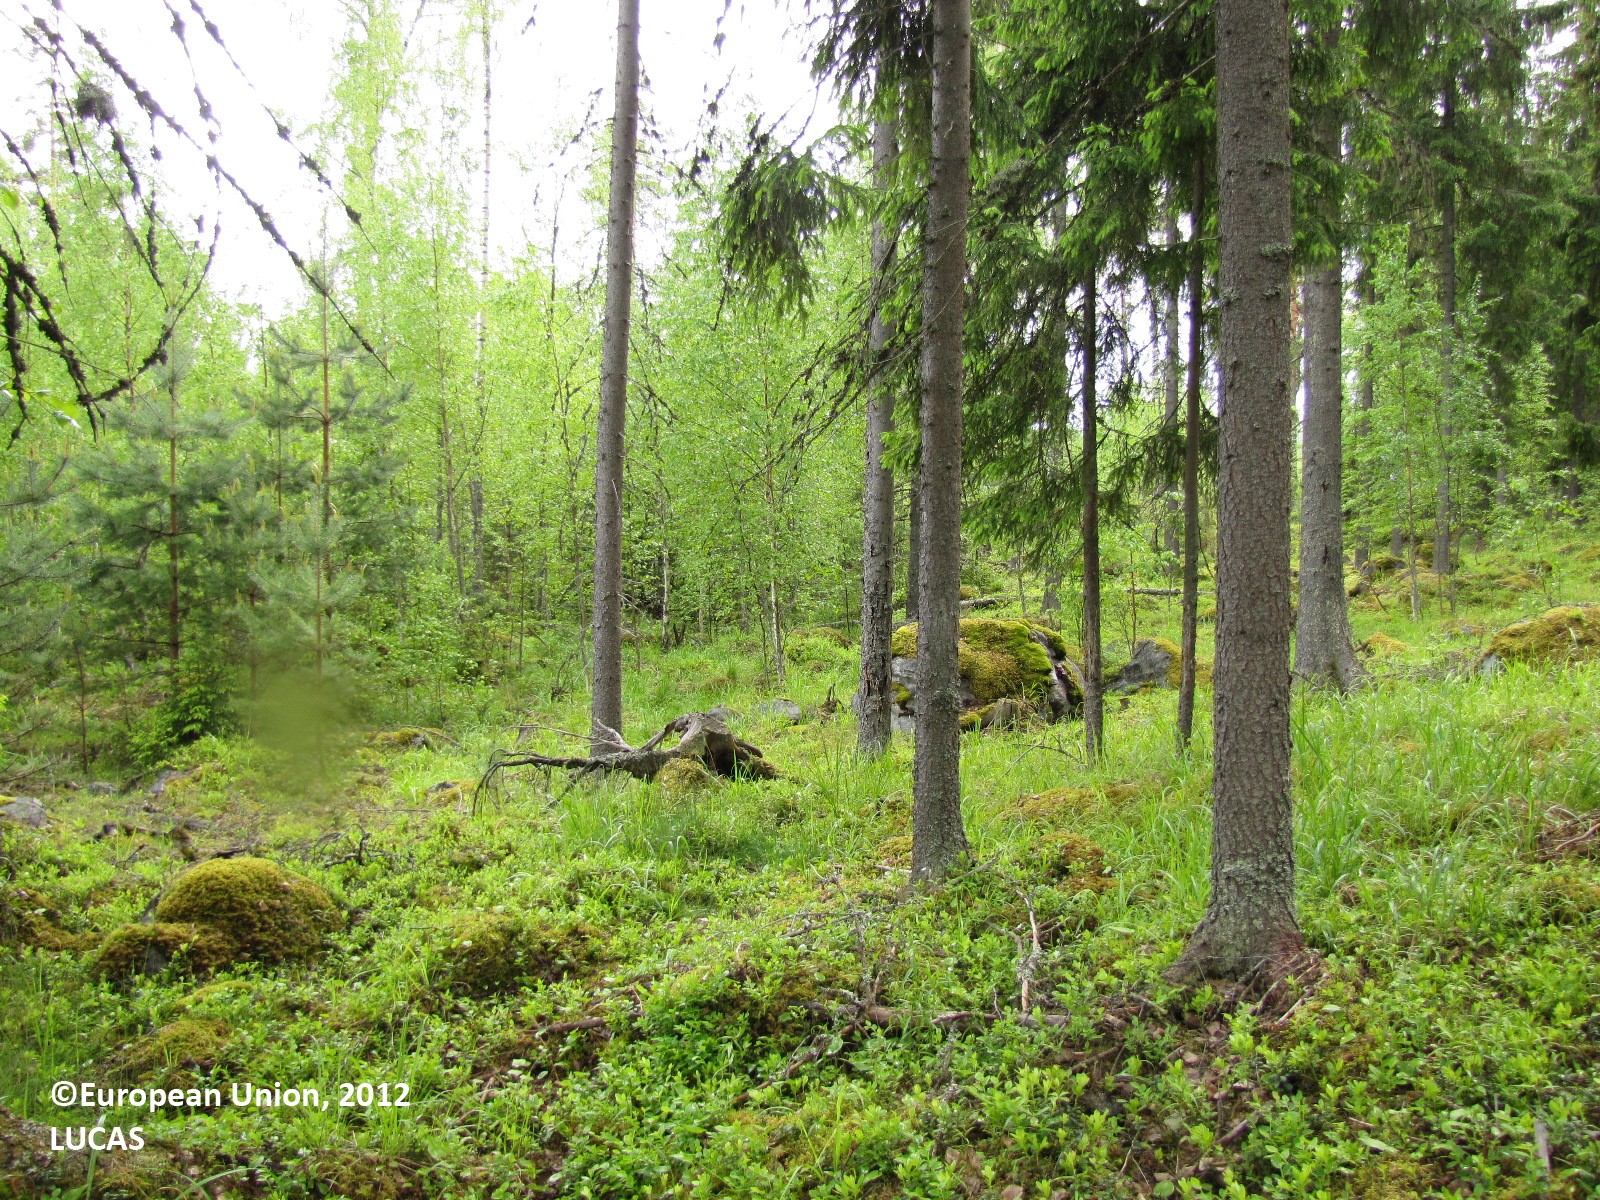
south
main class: Woodland
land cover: Spruce dominated coniferous woodland
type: boreal forest
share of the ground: > 75 %
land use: Forestry
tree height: > 5 m
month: June
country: FI
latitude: 61.2615
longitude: 23.5621
